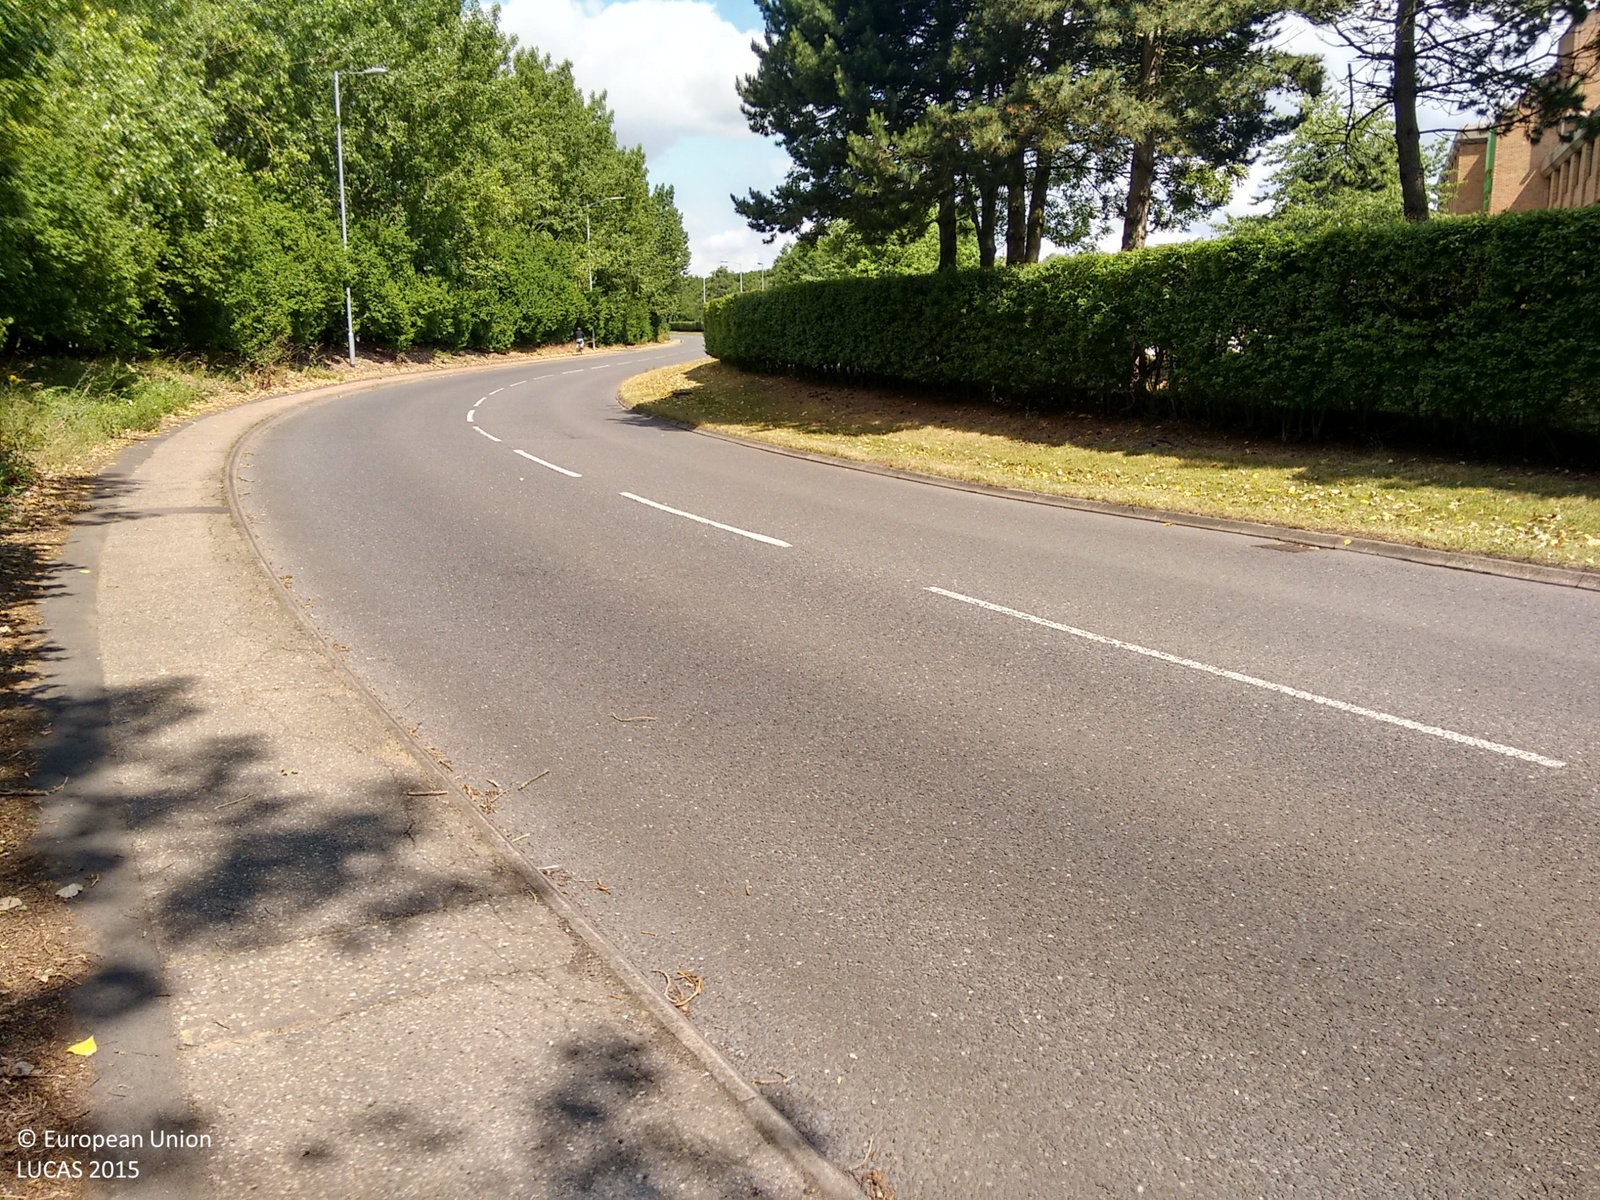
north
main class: Woodland
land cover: Broadleaved woodland
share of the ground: > 75 %
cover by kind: herbaceous plants 85 %, broadleaved forest trees 15 %
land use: Sport
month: July
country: GB
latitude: 52.5637
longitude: -0.2884
